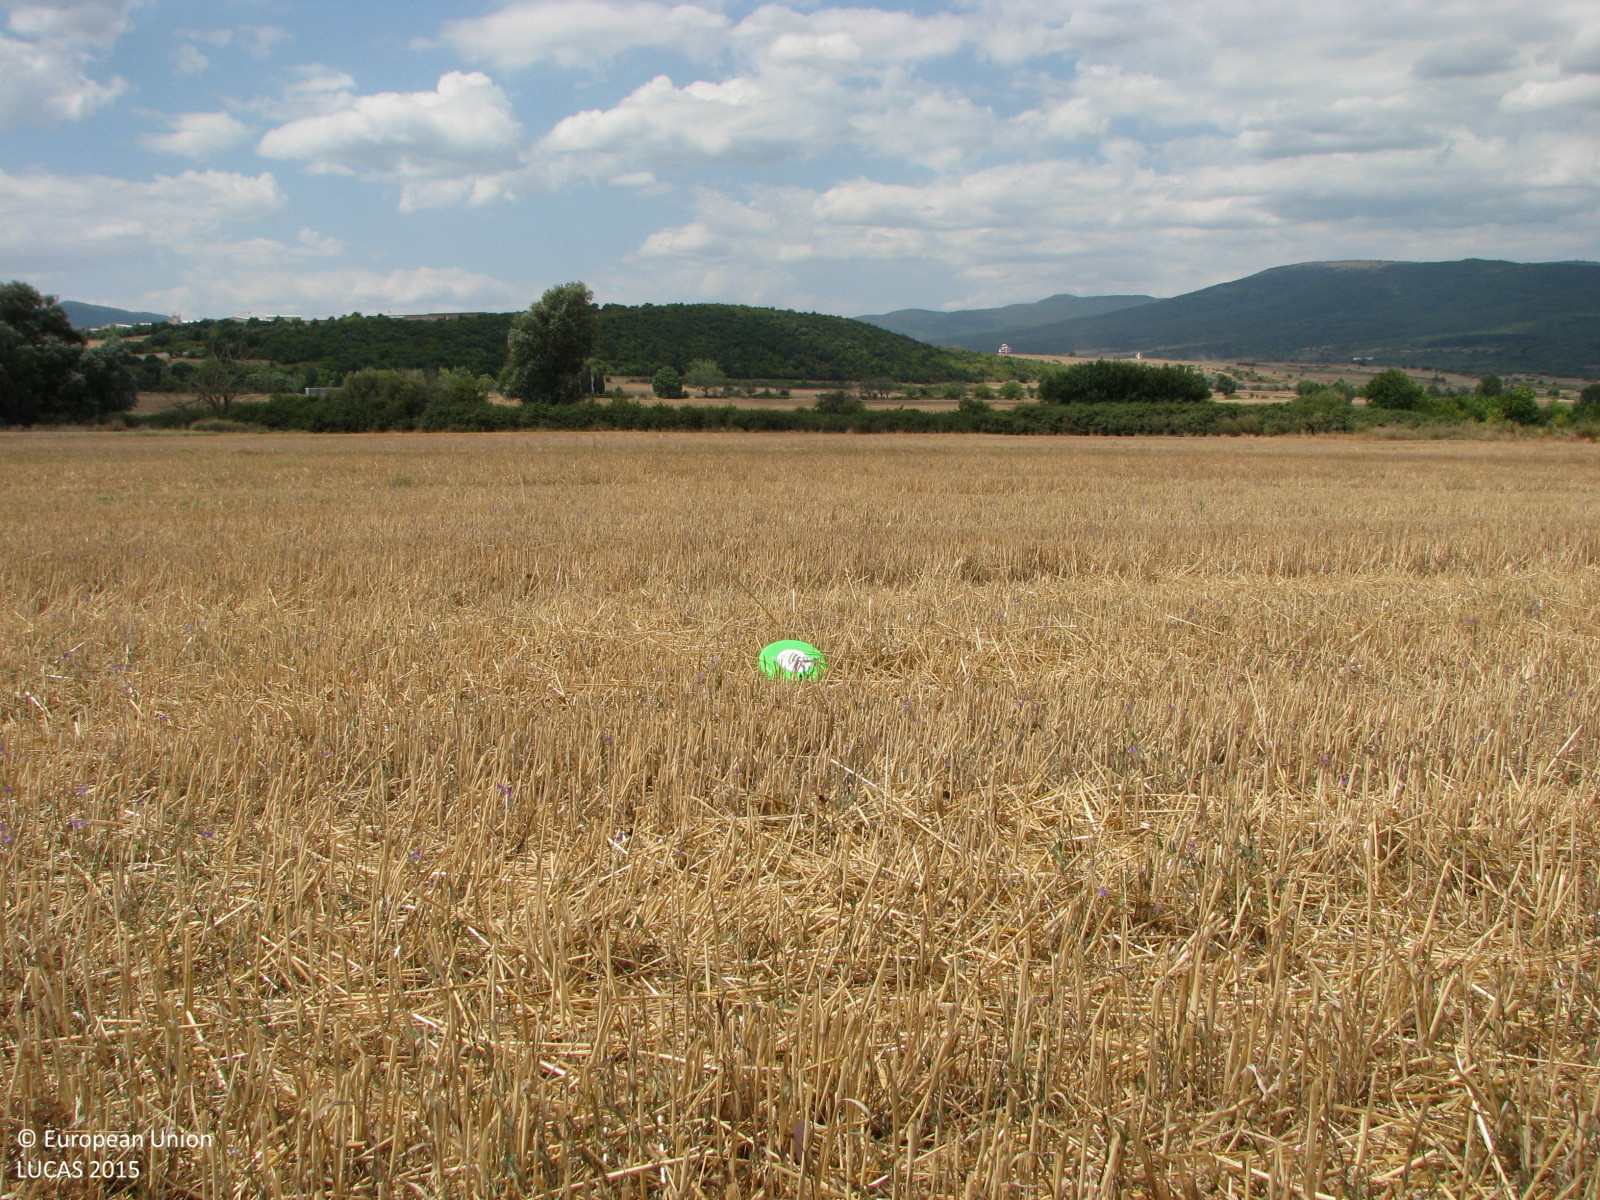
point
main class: Cropland
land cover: Common wheat
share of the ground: 50 - 75 %
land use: Agriculture (excluding fallow land and kitchen gardens)
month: August
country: BG
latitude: 42.7189
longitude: 26.6448
